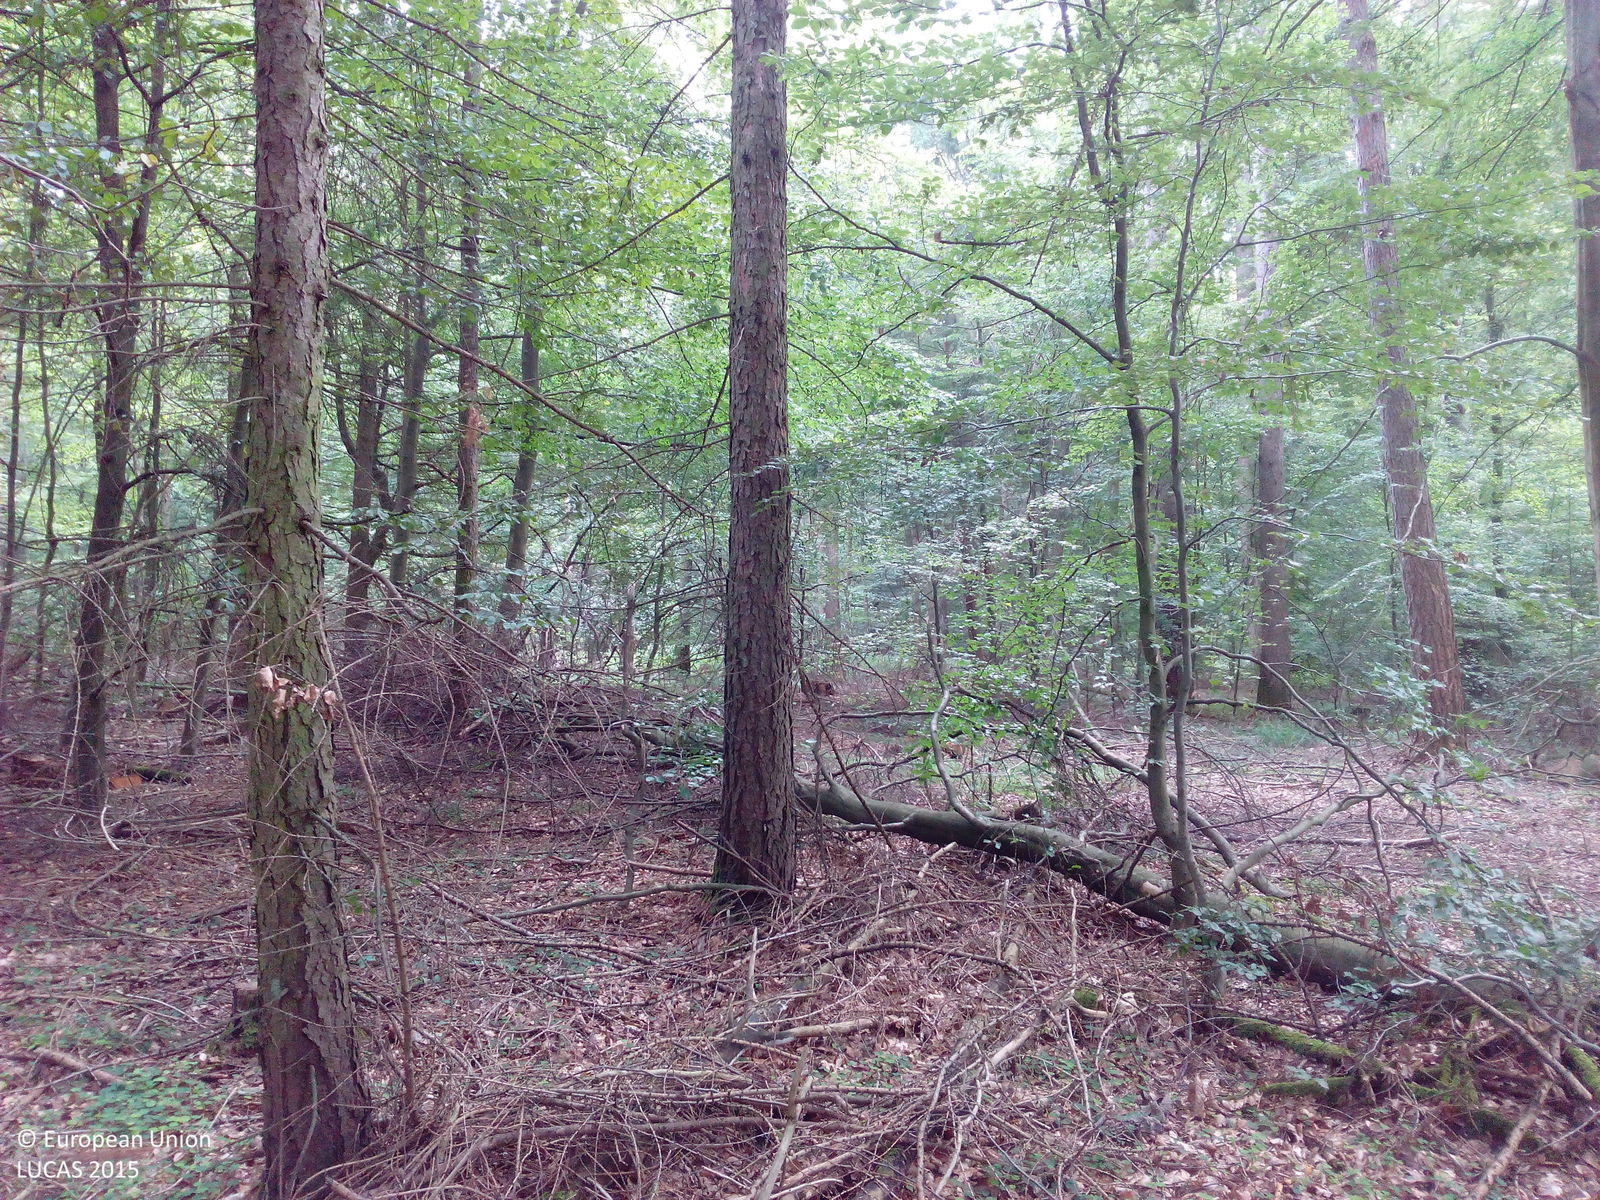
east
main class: Woodland
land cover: Spruce dominated mixed woodland
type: hemiboreal forest and nemoral coniferous forest and mixed broadleaved-coniferous forest
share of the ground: > 75 %
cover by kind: coniferous forest trees 60 %, broadleaved forest trees 40 %
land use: Forestry
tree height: > 5 m
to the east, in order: Spruce dominated mixed woodland; Broadleaved woodland
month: September
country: DE
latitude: 51.3887
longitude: 9.8420
